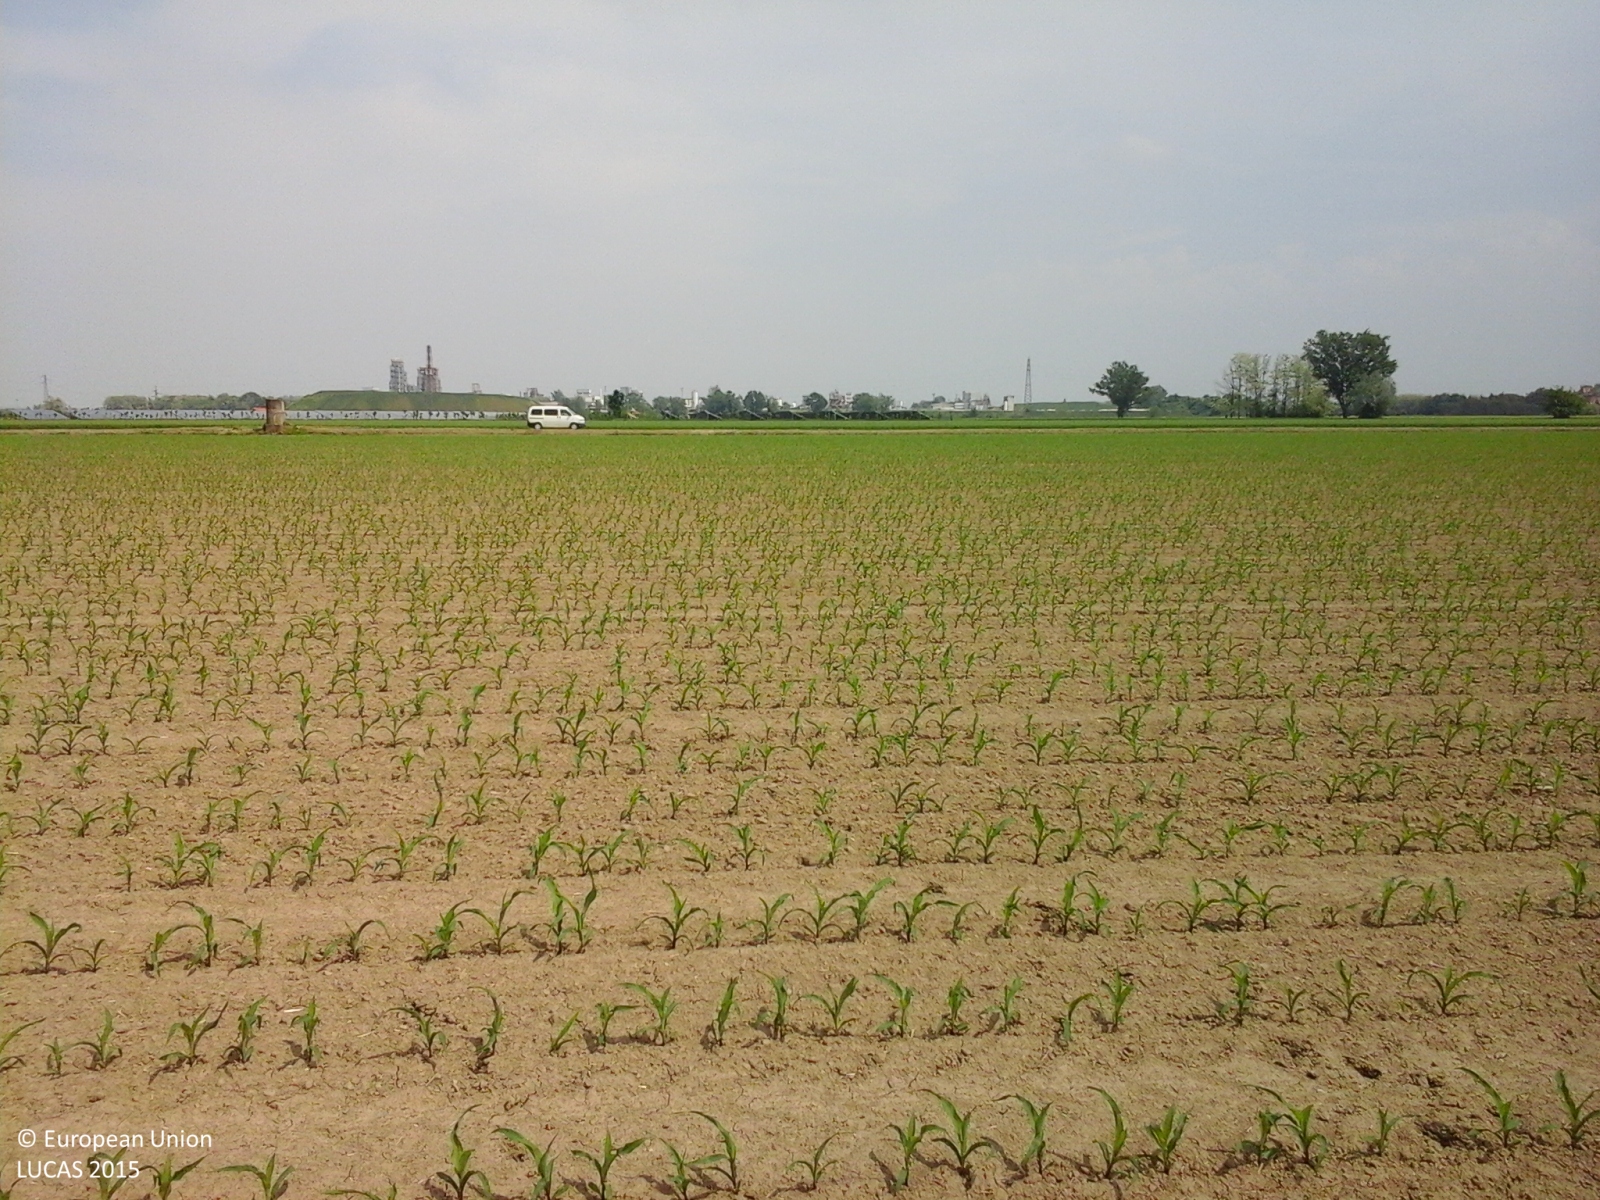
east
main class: Cropland
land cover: Maize
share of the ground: < 10 %
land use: Agriculture (excluding fallow land and kitchen gardens)
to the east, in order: Maize; Grass margins; Tracks; Grass margins; Common wheat
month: May
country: IT
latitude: 44.8828
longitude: 8.6480
